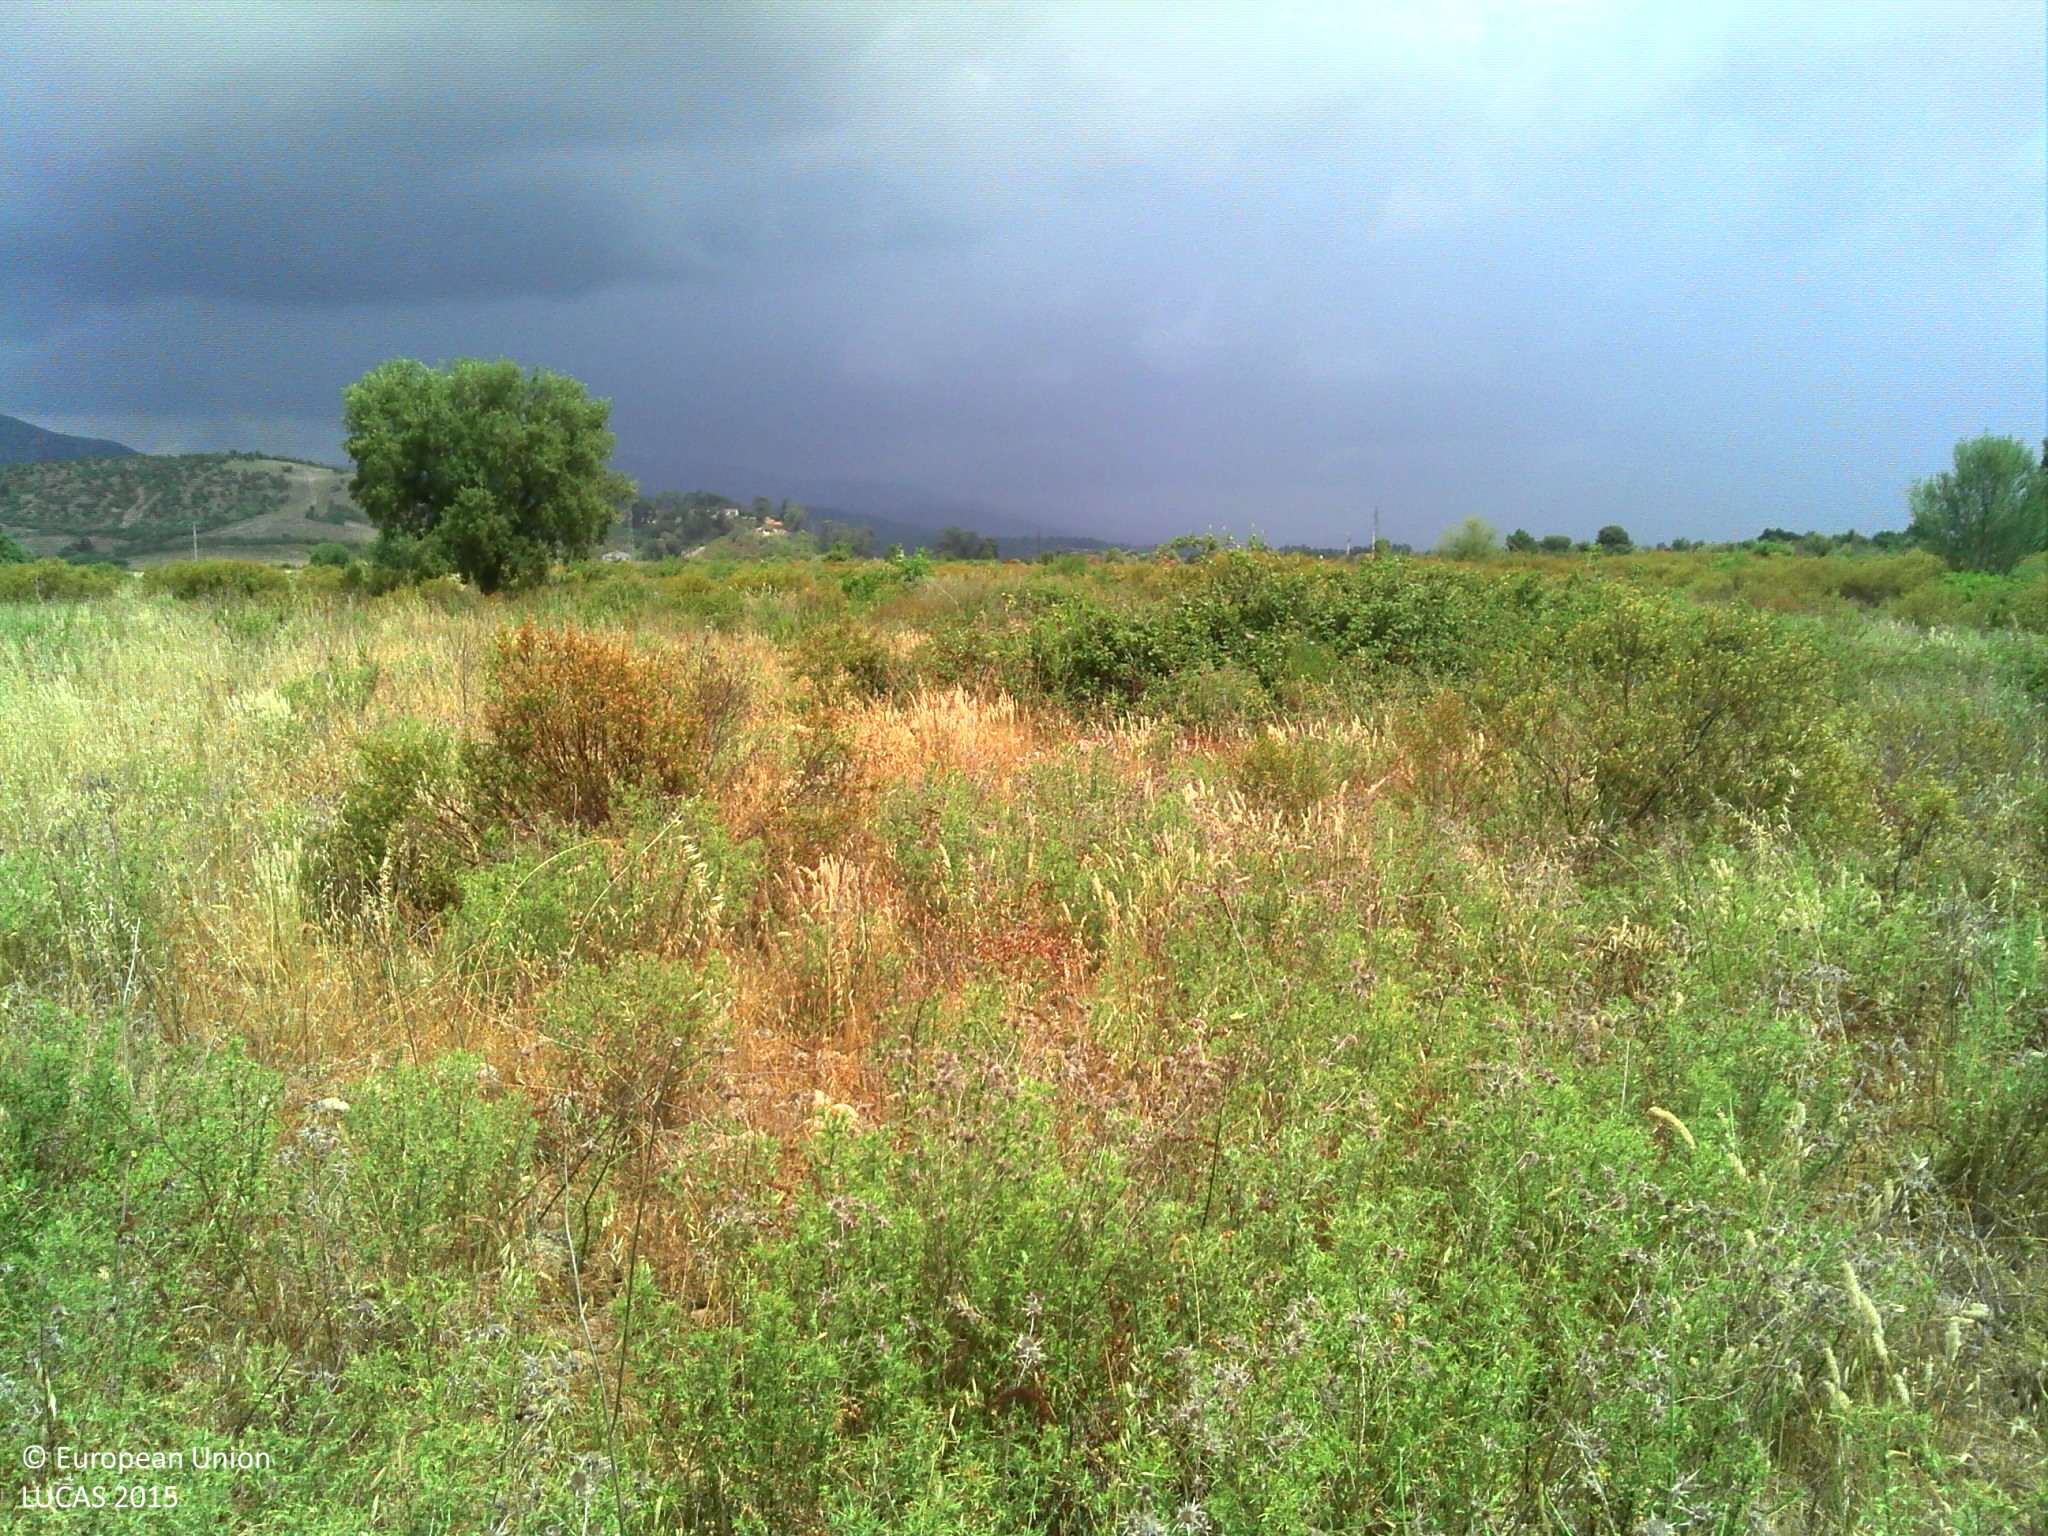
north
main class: Shrubland
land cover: Shrubland without tree cover
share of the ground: > 75 %
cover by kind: shrubs 85 %, herbaceous plants 15 %
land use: Agriculture (excluding fallow land and kitchen gardens)
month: July
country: FR
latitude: 42.0558
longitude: 9.3620
